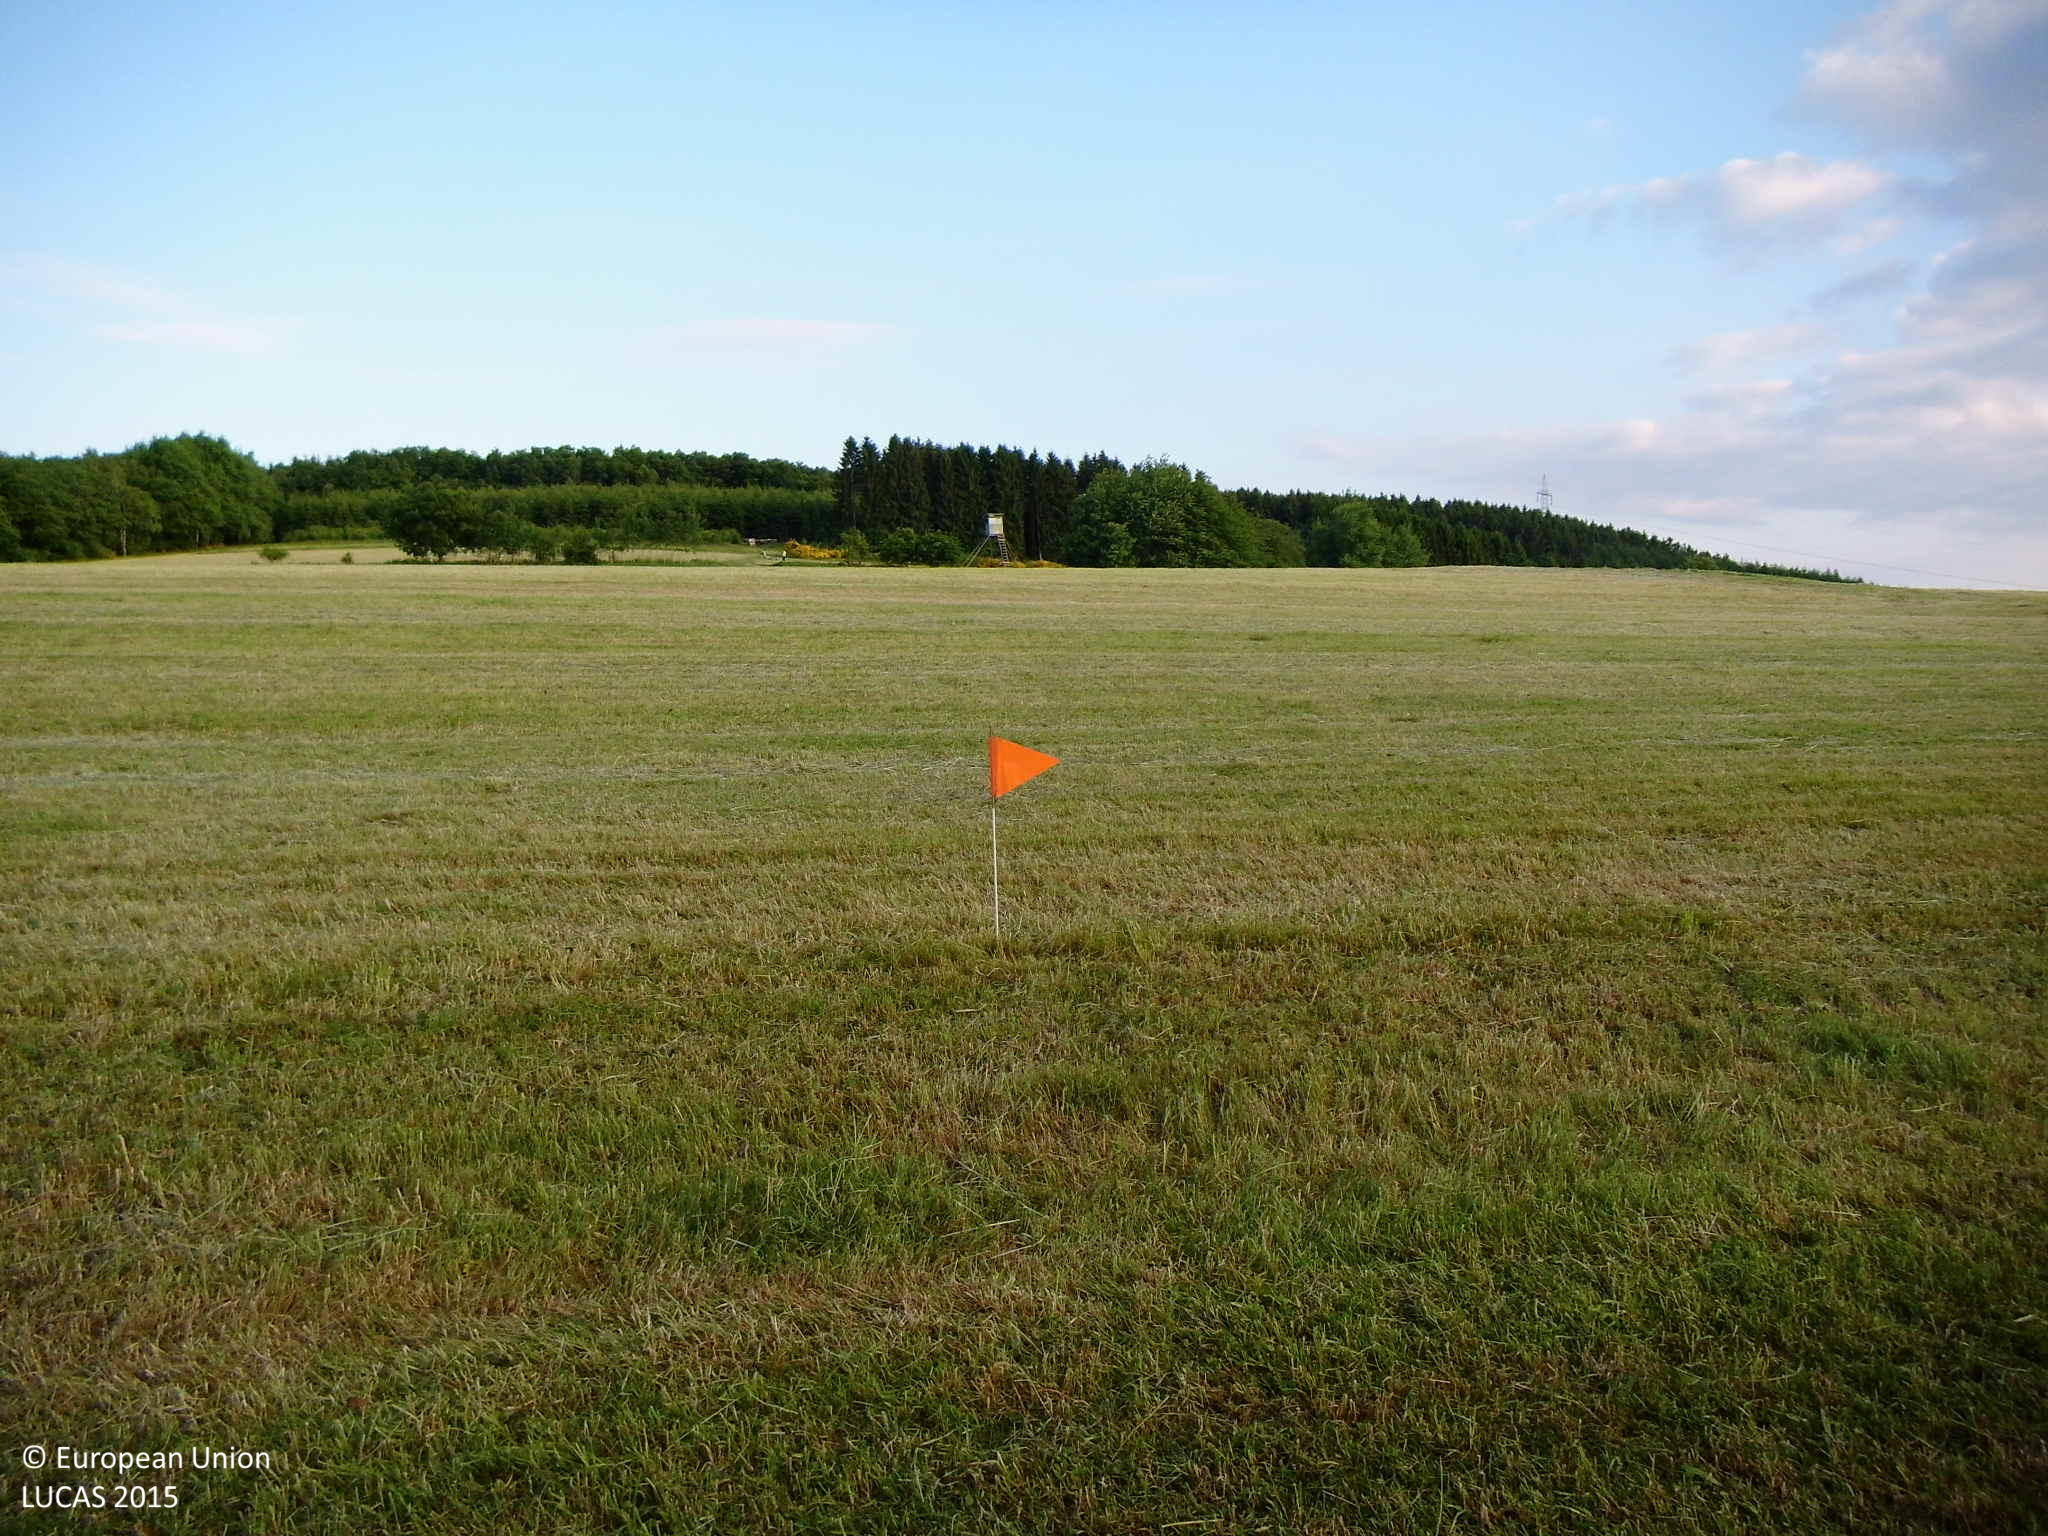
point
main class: Grassland
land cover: Grassland without tree/shrub cover
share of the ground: > 75 %
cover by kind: herbaceous plants 100 %
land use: Agriculture (excluding fallow land and kitchen gardens)
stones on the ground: 10 - 25 %
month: June
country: DE
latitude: 50.9235
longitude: 8.0798
